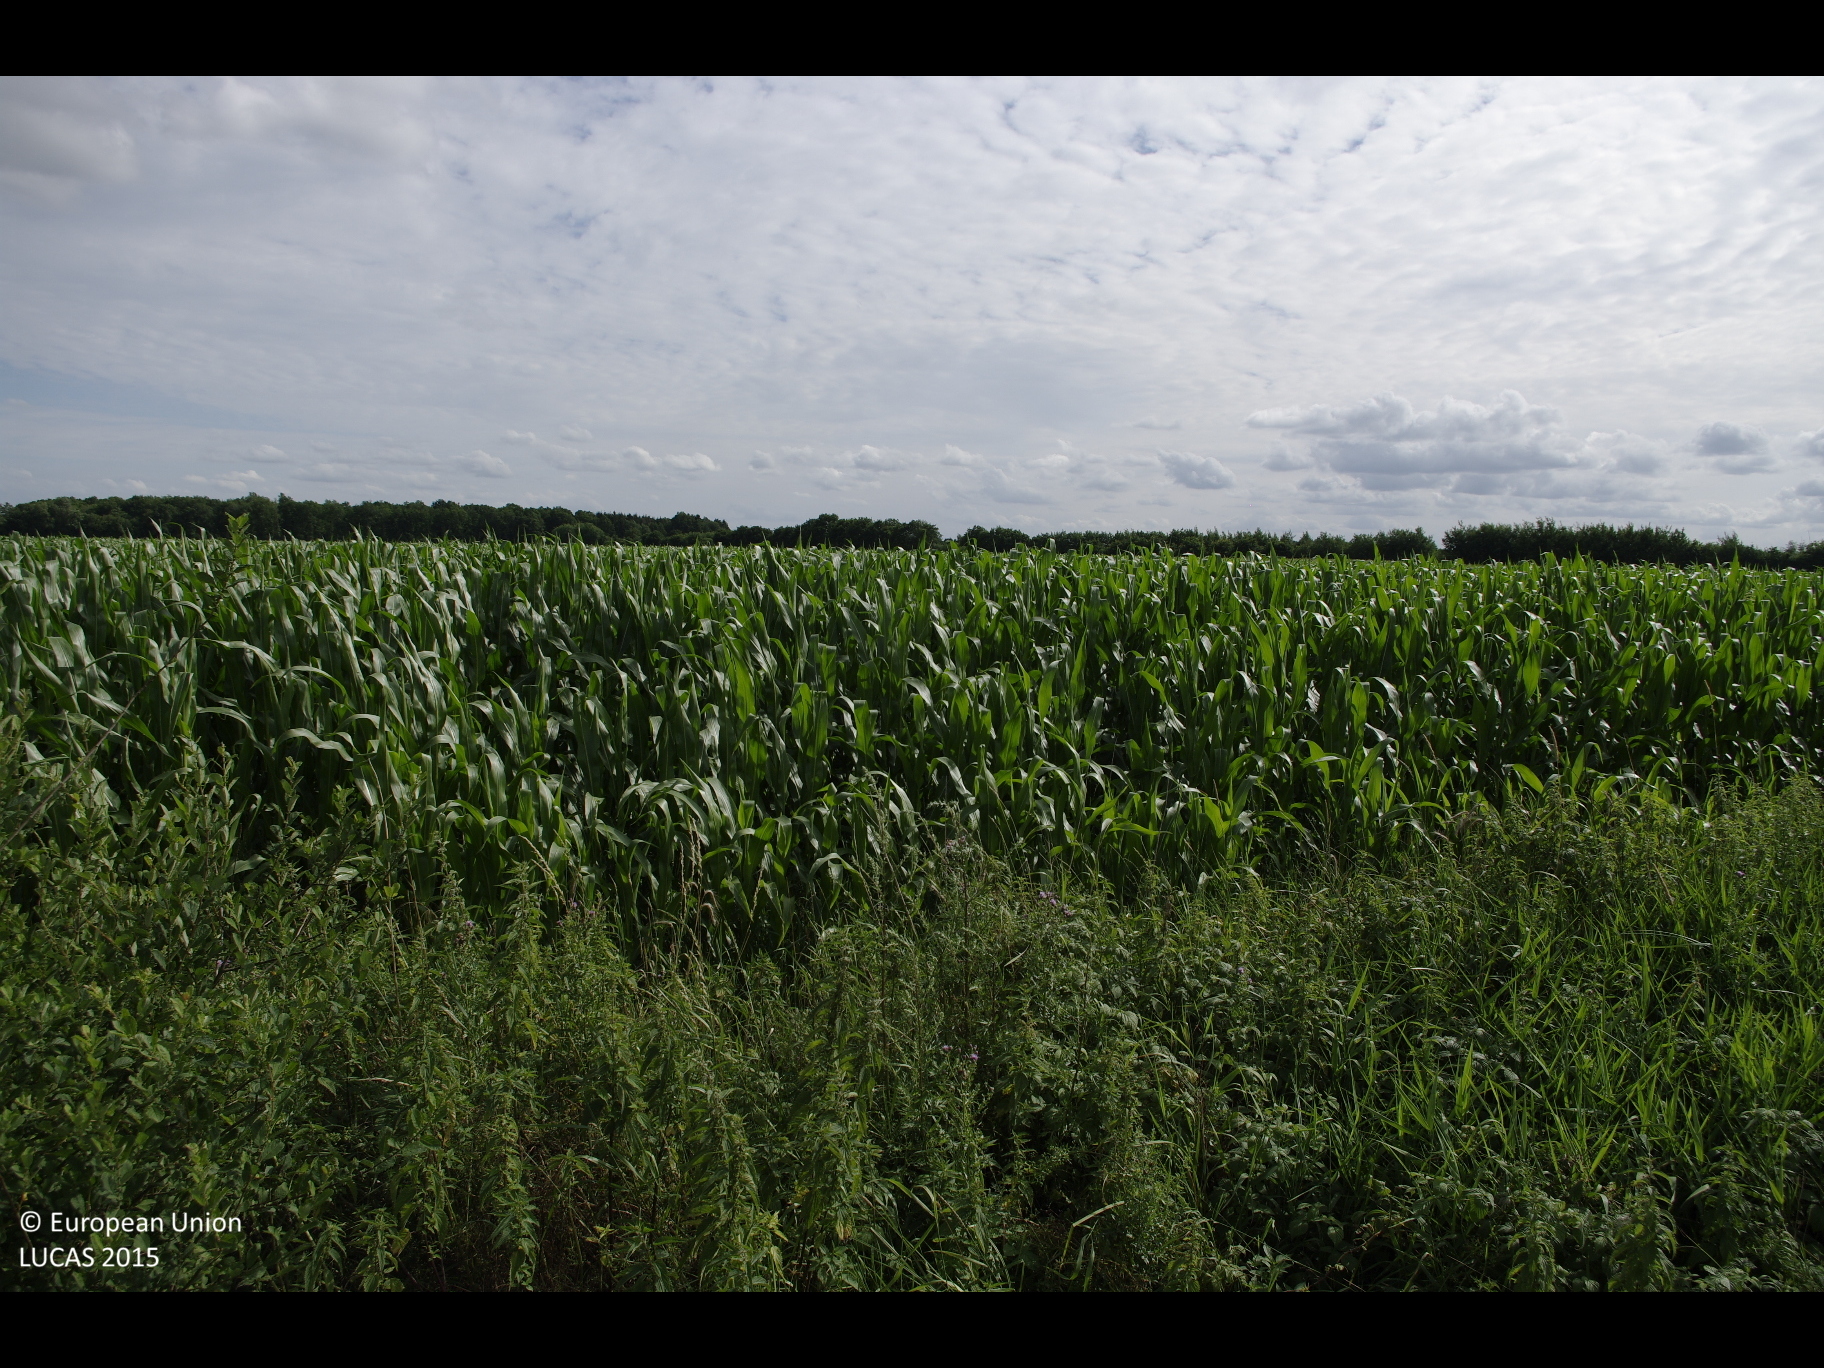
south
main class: Cropland
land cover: Maize
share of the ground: > 75 %
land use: Agriculture (excluding fallow land and kitchen gardens)
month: July
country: DE
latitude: 54.0309
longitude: 9.9237
